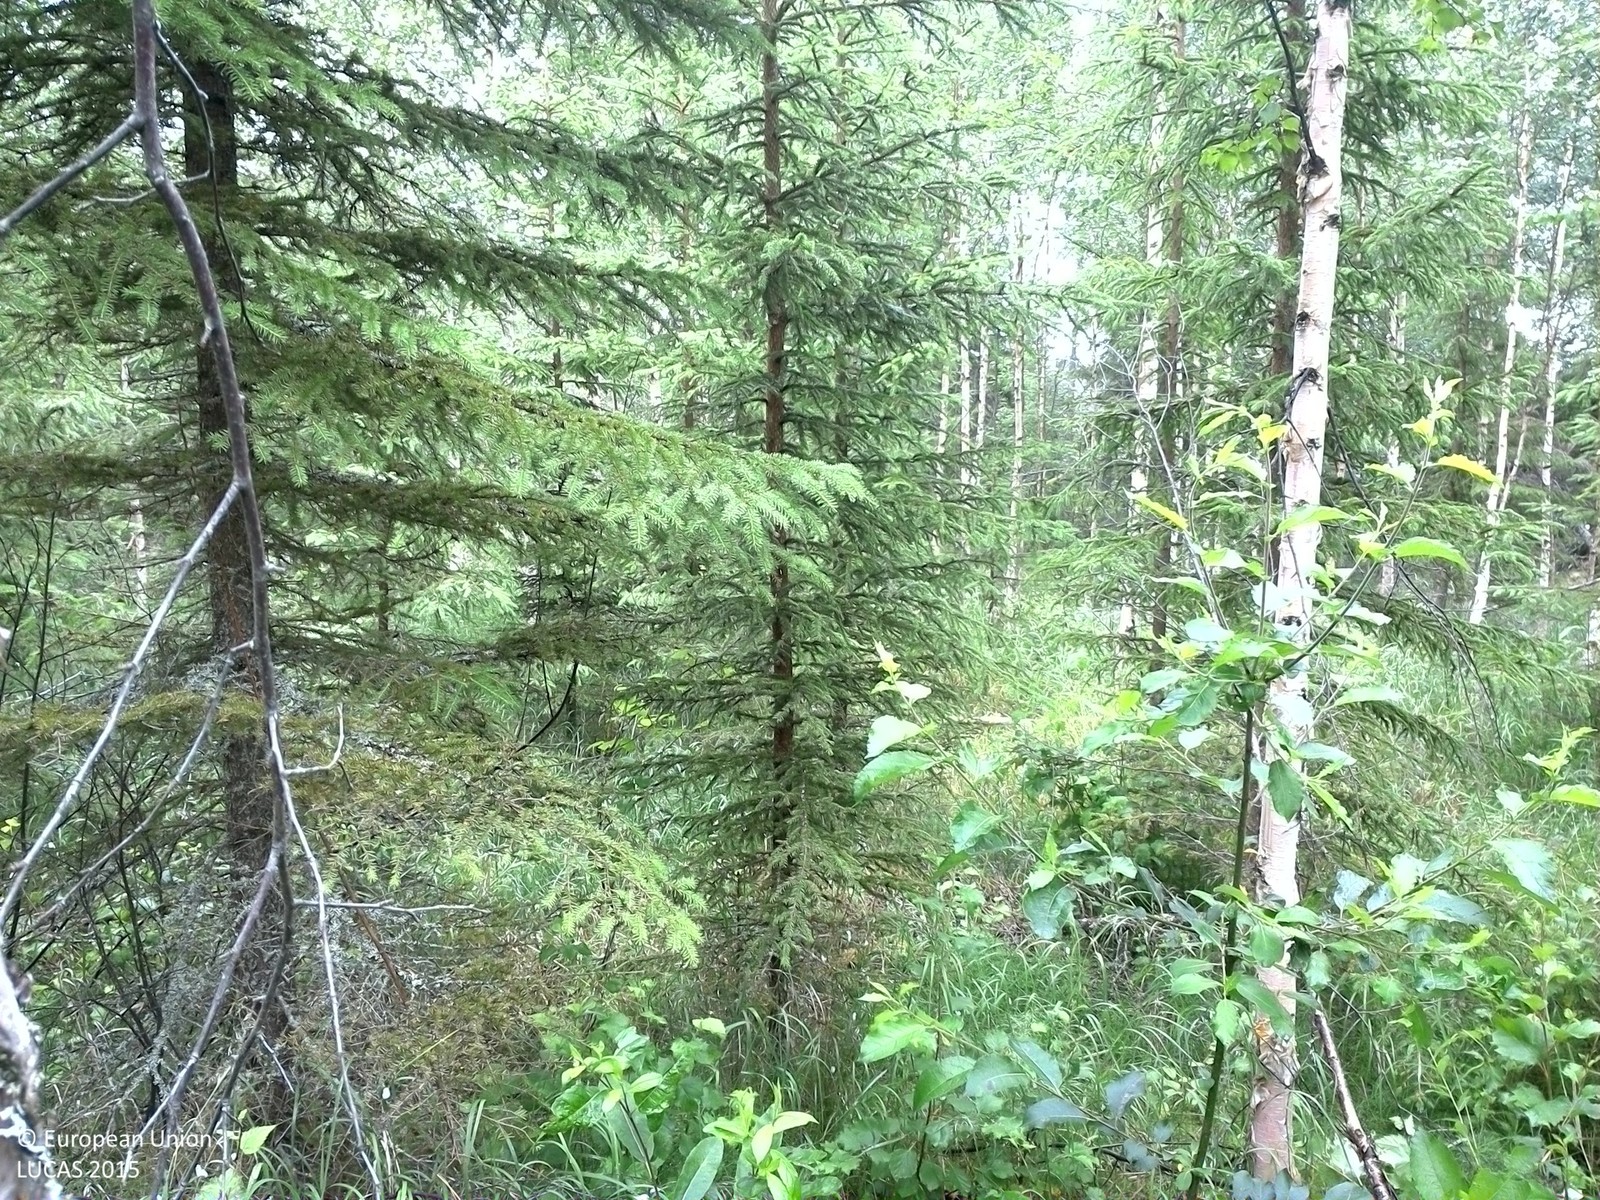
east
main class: Woodland
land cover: Spruce dominated mixed woodland
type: boreal forest
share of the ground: 50 - 75 %
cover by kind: coniferous forest trees 35 %, broadleaved forest trees 35 %, herbaceous plants 25 %, lichens and mosses 5 %
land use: Forestry
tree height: > 5 m
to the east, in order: Spruce dominated mixed woodland; Inland fresh water bodies; Spruce dominated mixed woodland; Pine dominated mixed woodland
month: August
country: SE
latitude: 63.5643
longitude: 16.3557
